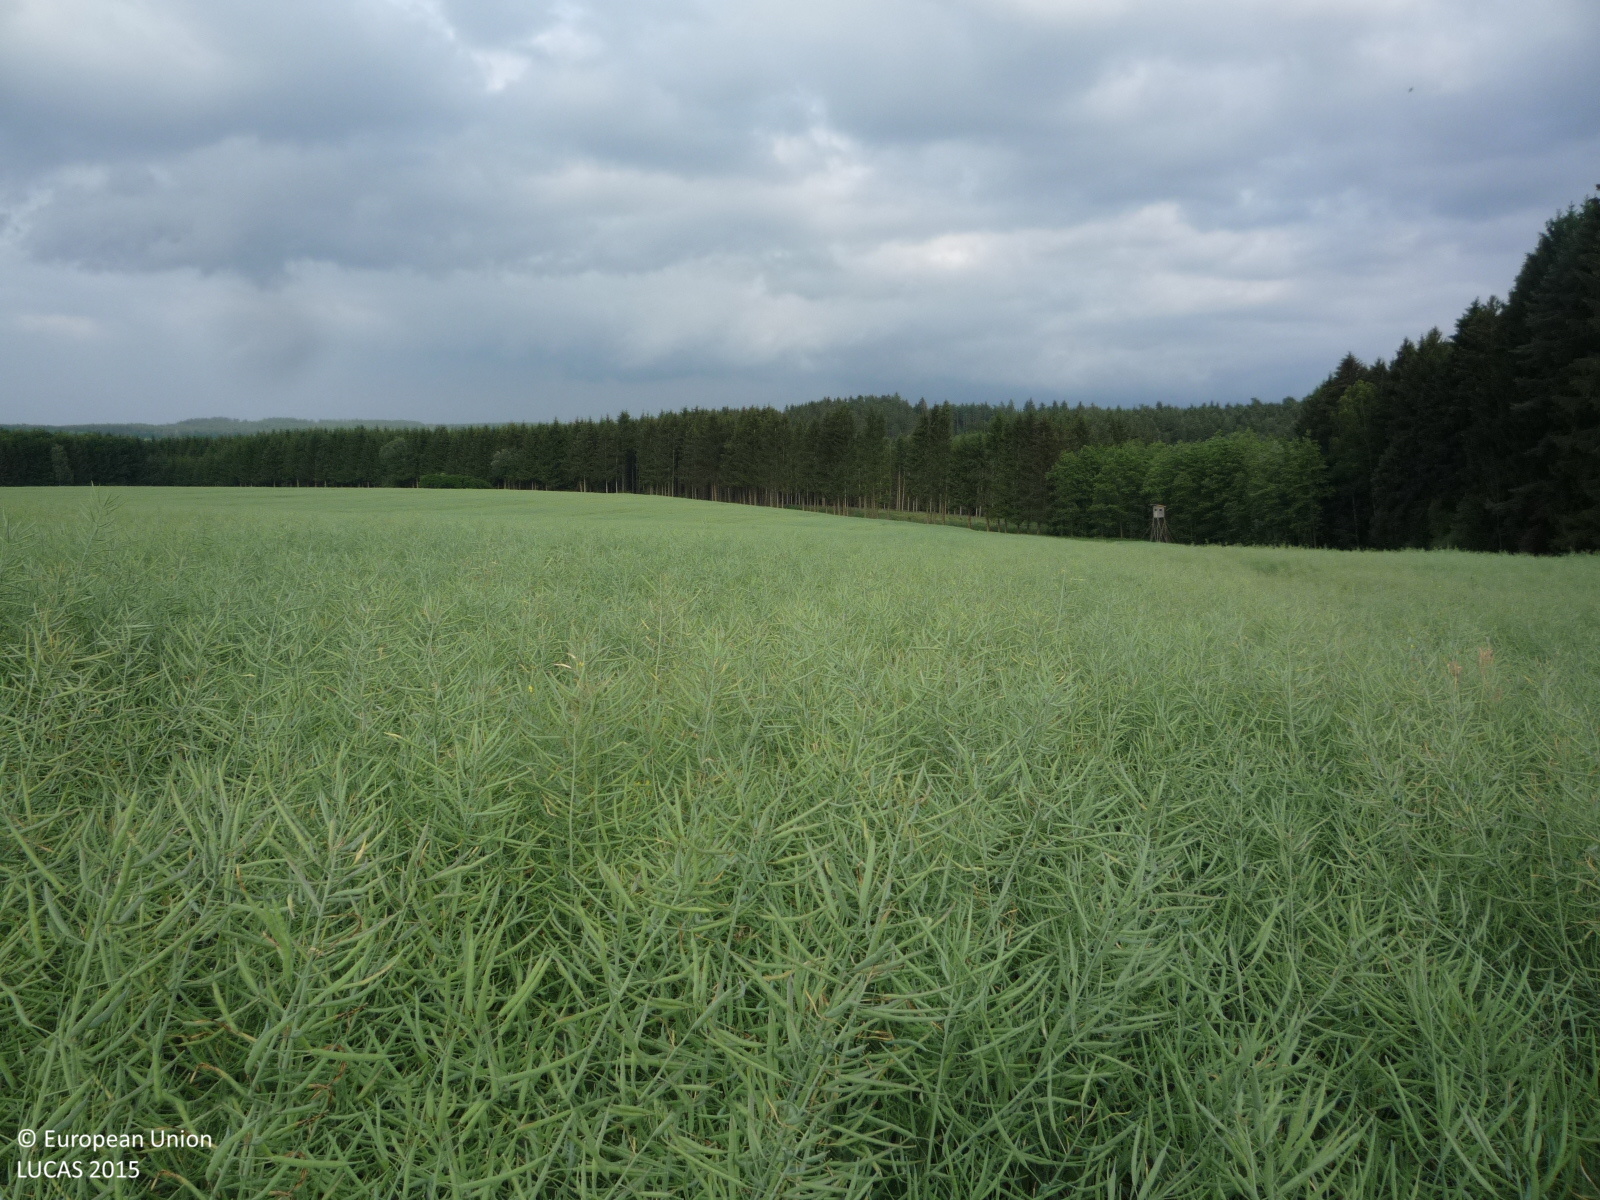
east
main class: Cropland
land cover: Rape and turnip rape
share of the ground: > 75 %
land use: Agriculture (excluding fallow land and kitchen gardens)
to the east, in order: Rape and turnip rape
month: June
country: CZ
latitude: 49.6909
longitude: 15.1180
